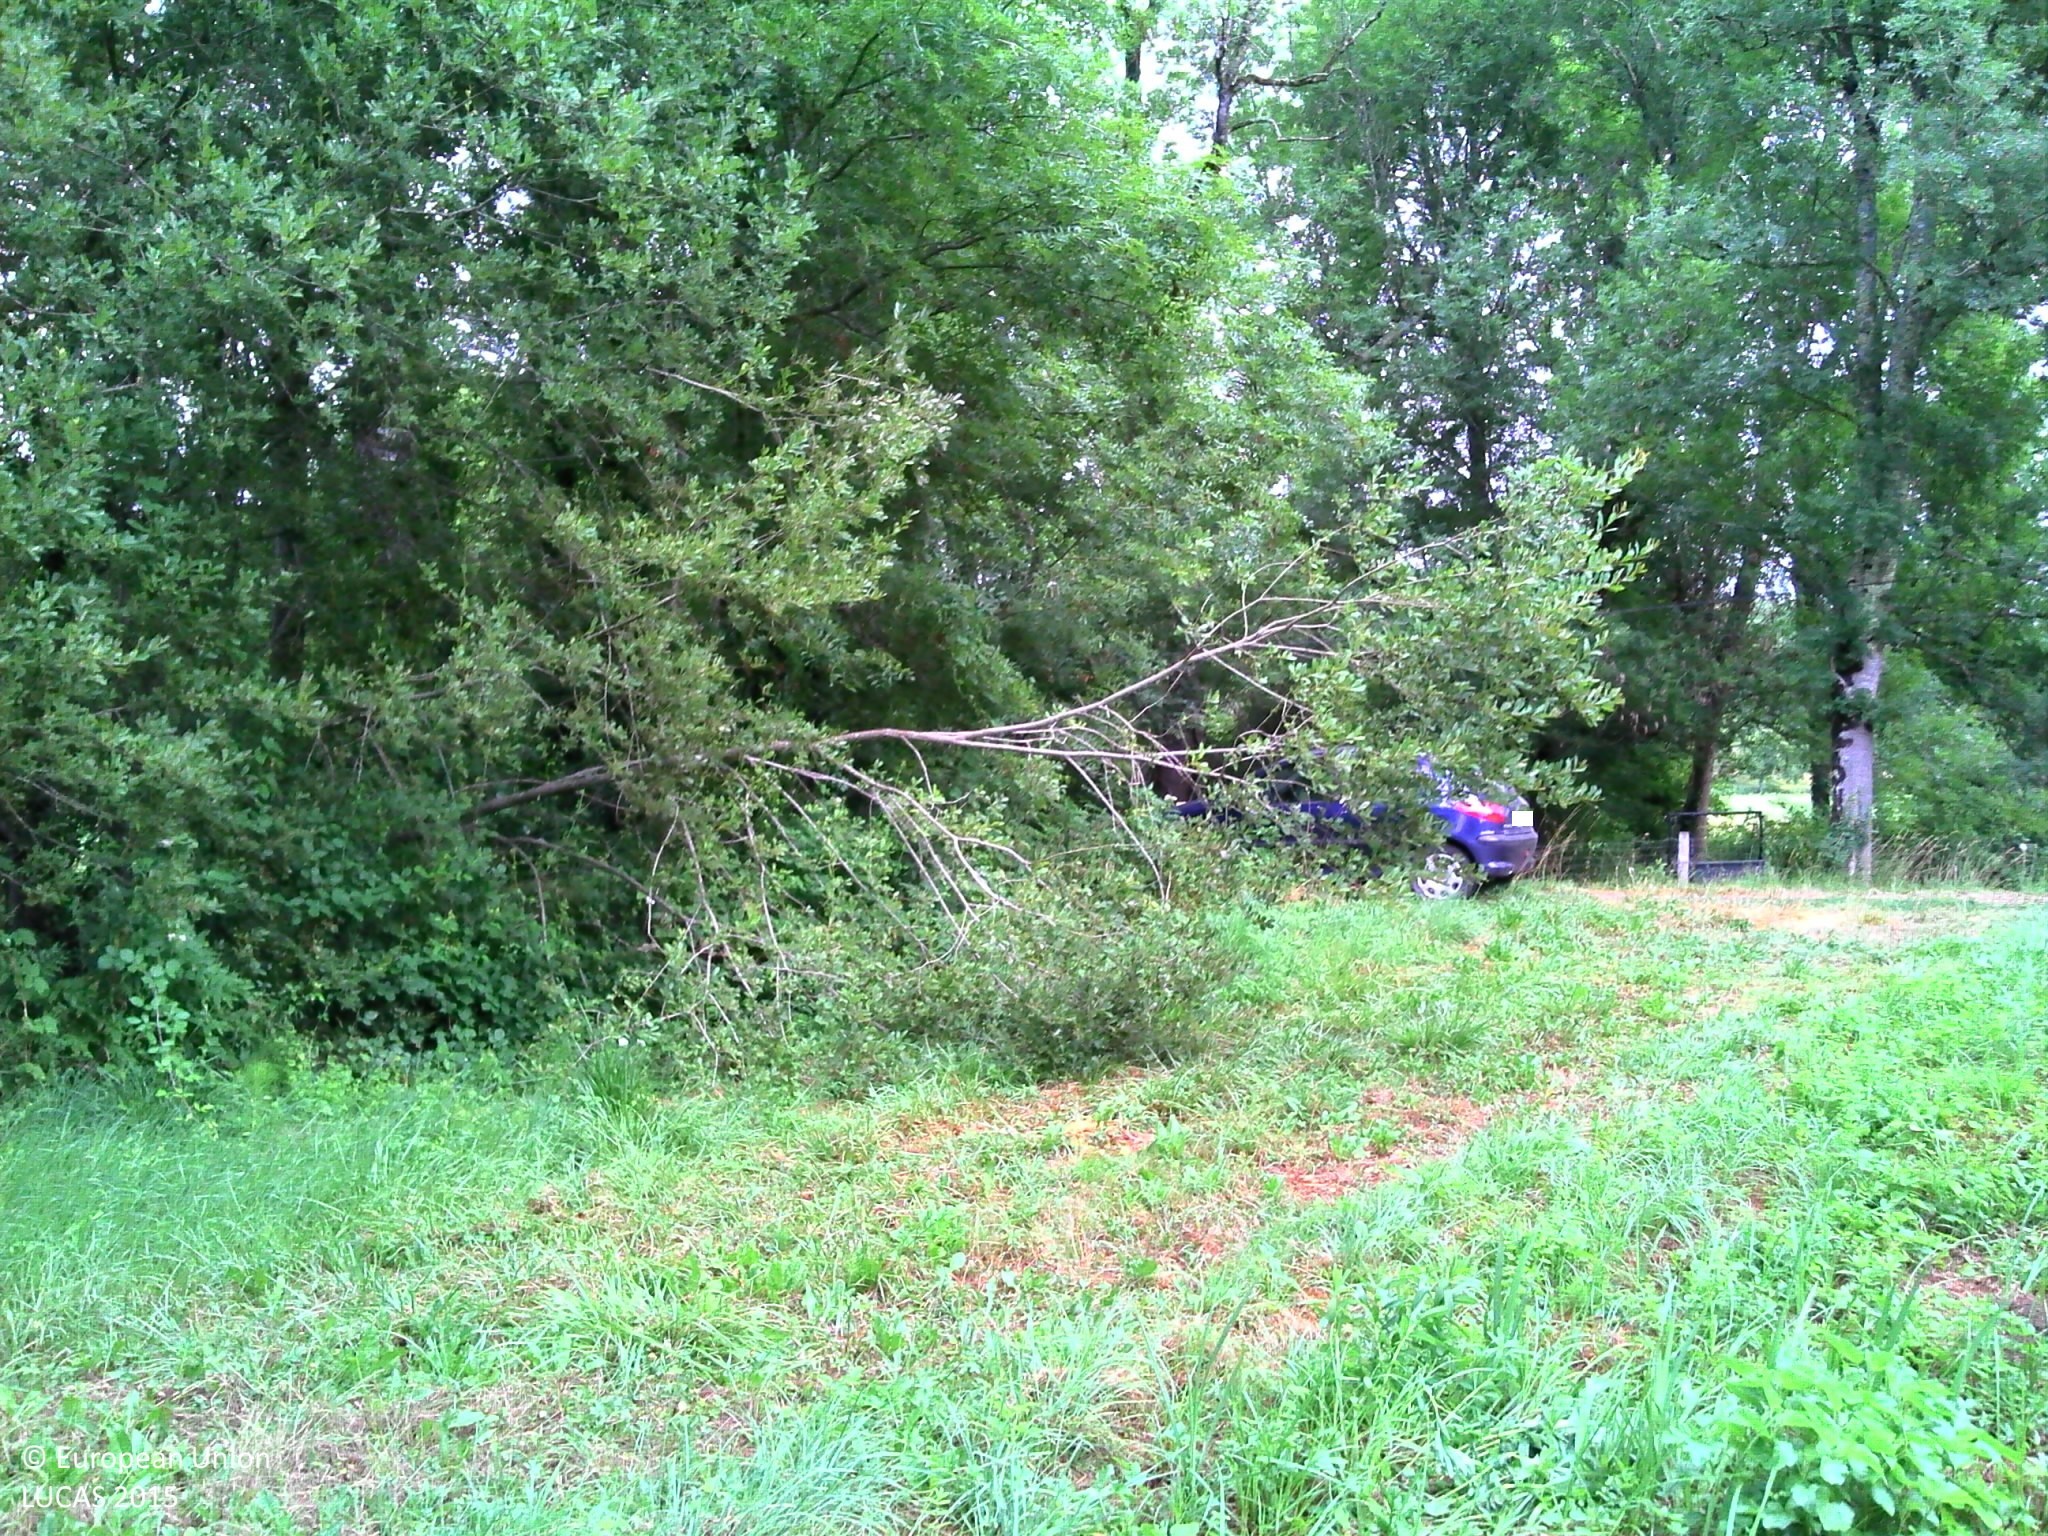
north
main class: Grassland
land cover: Spontaneously vegetated surfaces
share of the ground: > 75 %
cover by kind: herbaceous plants 95 %, shrubs 5 %
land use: Semi-natural and natural areas not in use
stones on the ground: < 10 %
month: July
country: FR
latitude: 44.9369
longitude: 0.7793
